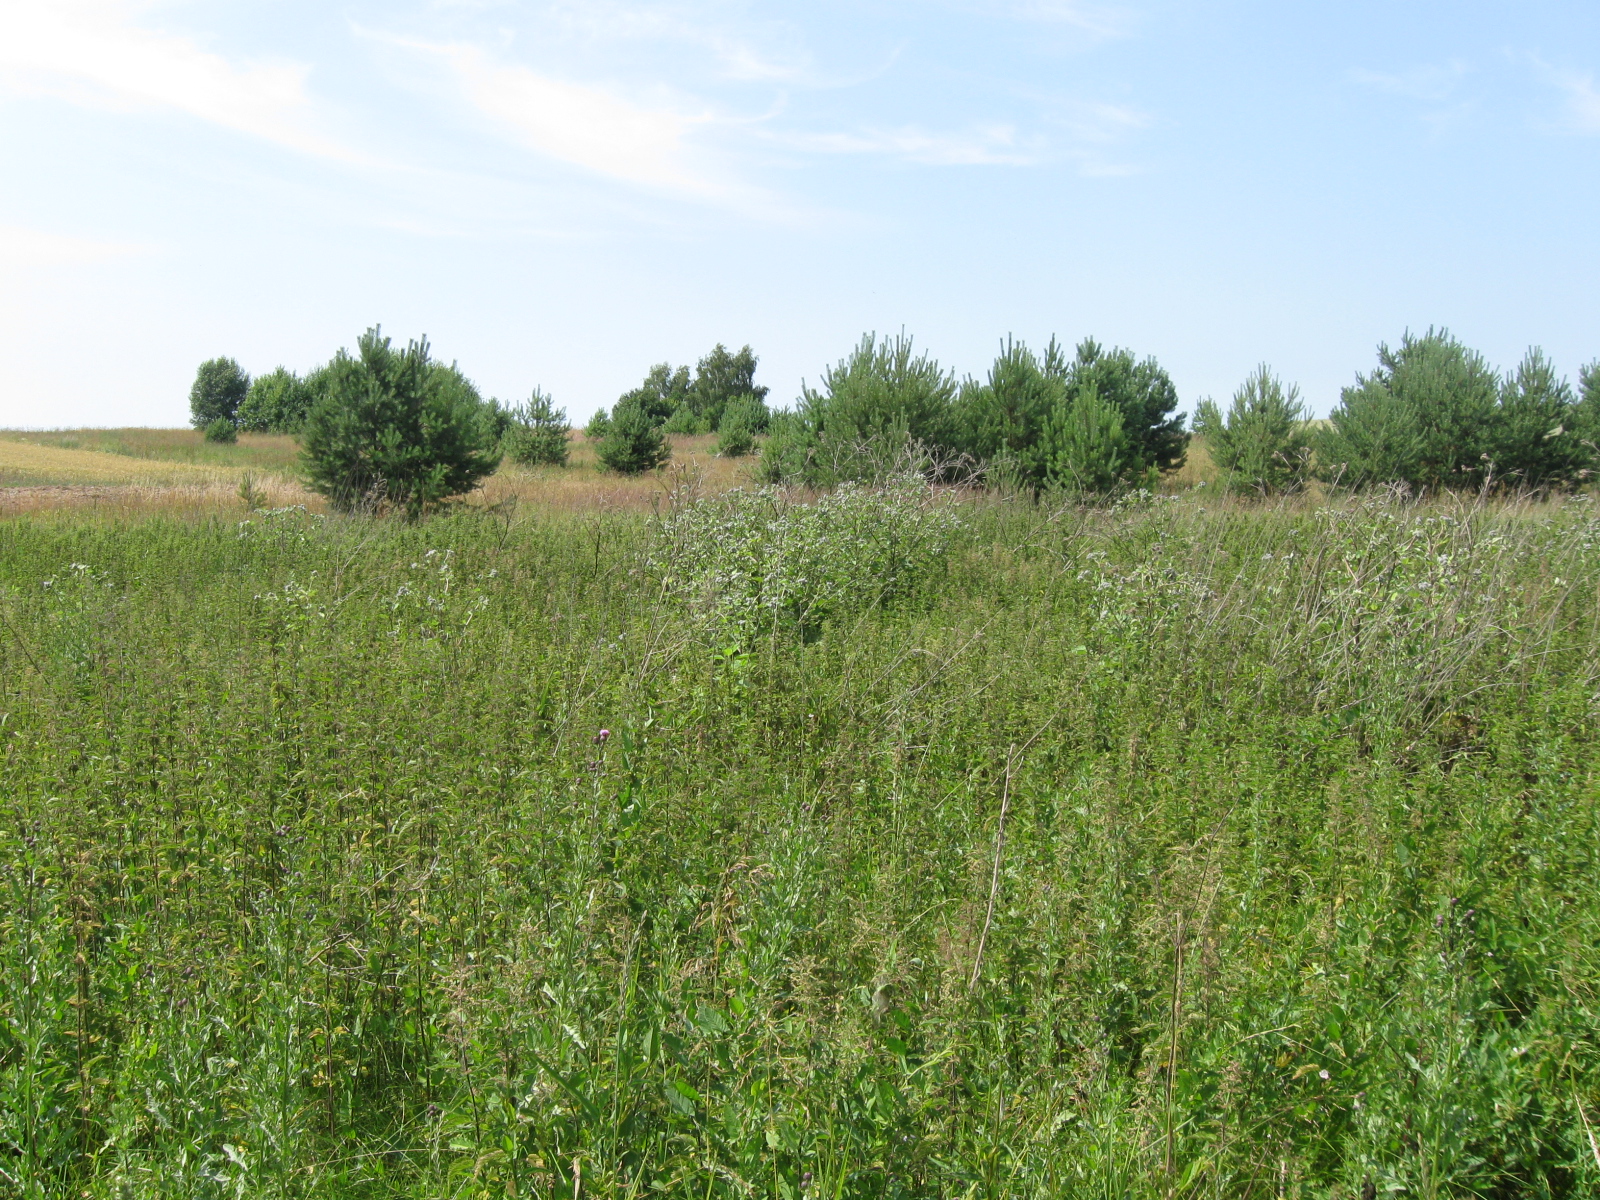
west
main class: Grassland
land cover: Spontaneously vegetated surfaces
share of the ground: > 75 %
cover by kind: herbaceous plants 100 %
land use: Fallow land
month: July
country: LT
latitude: 54.7079
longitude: 23.9502
